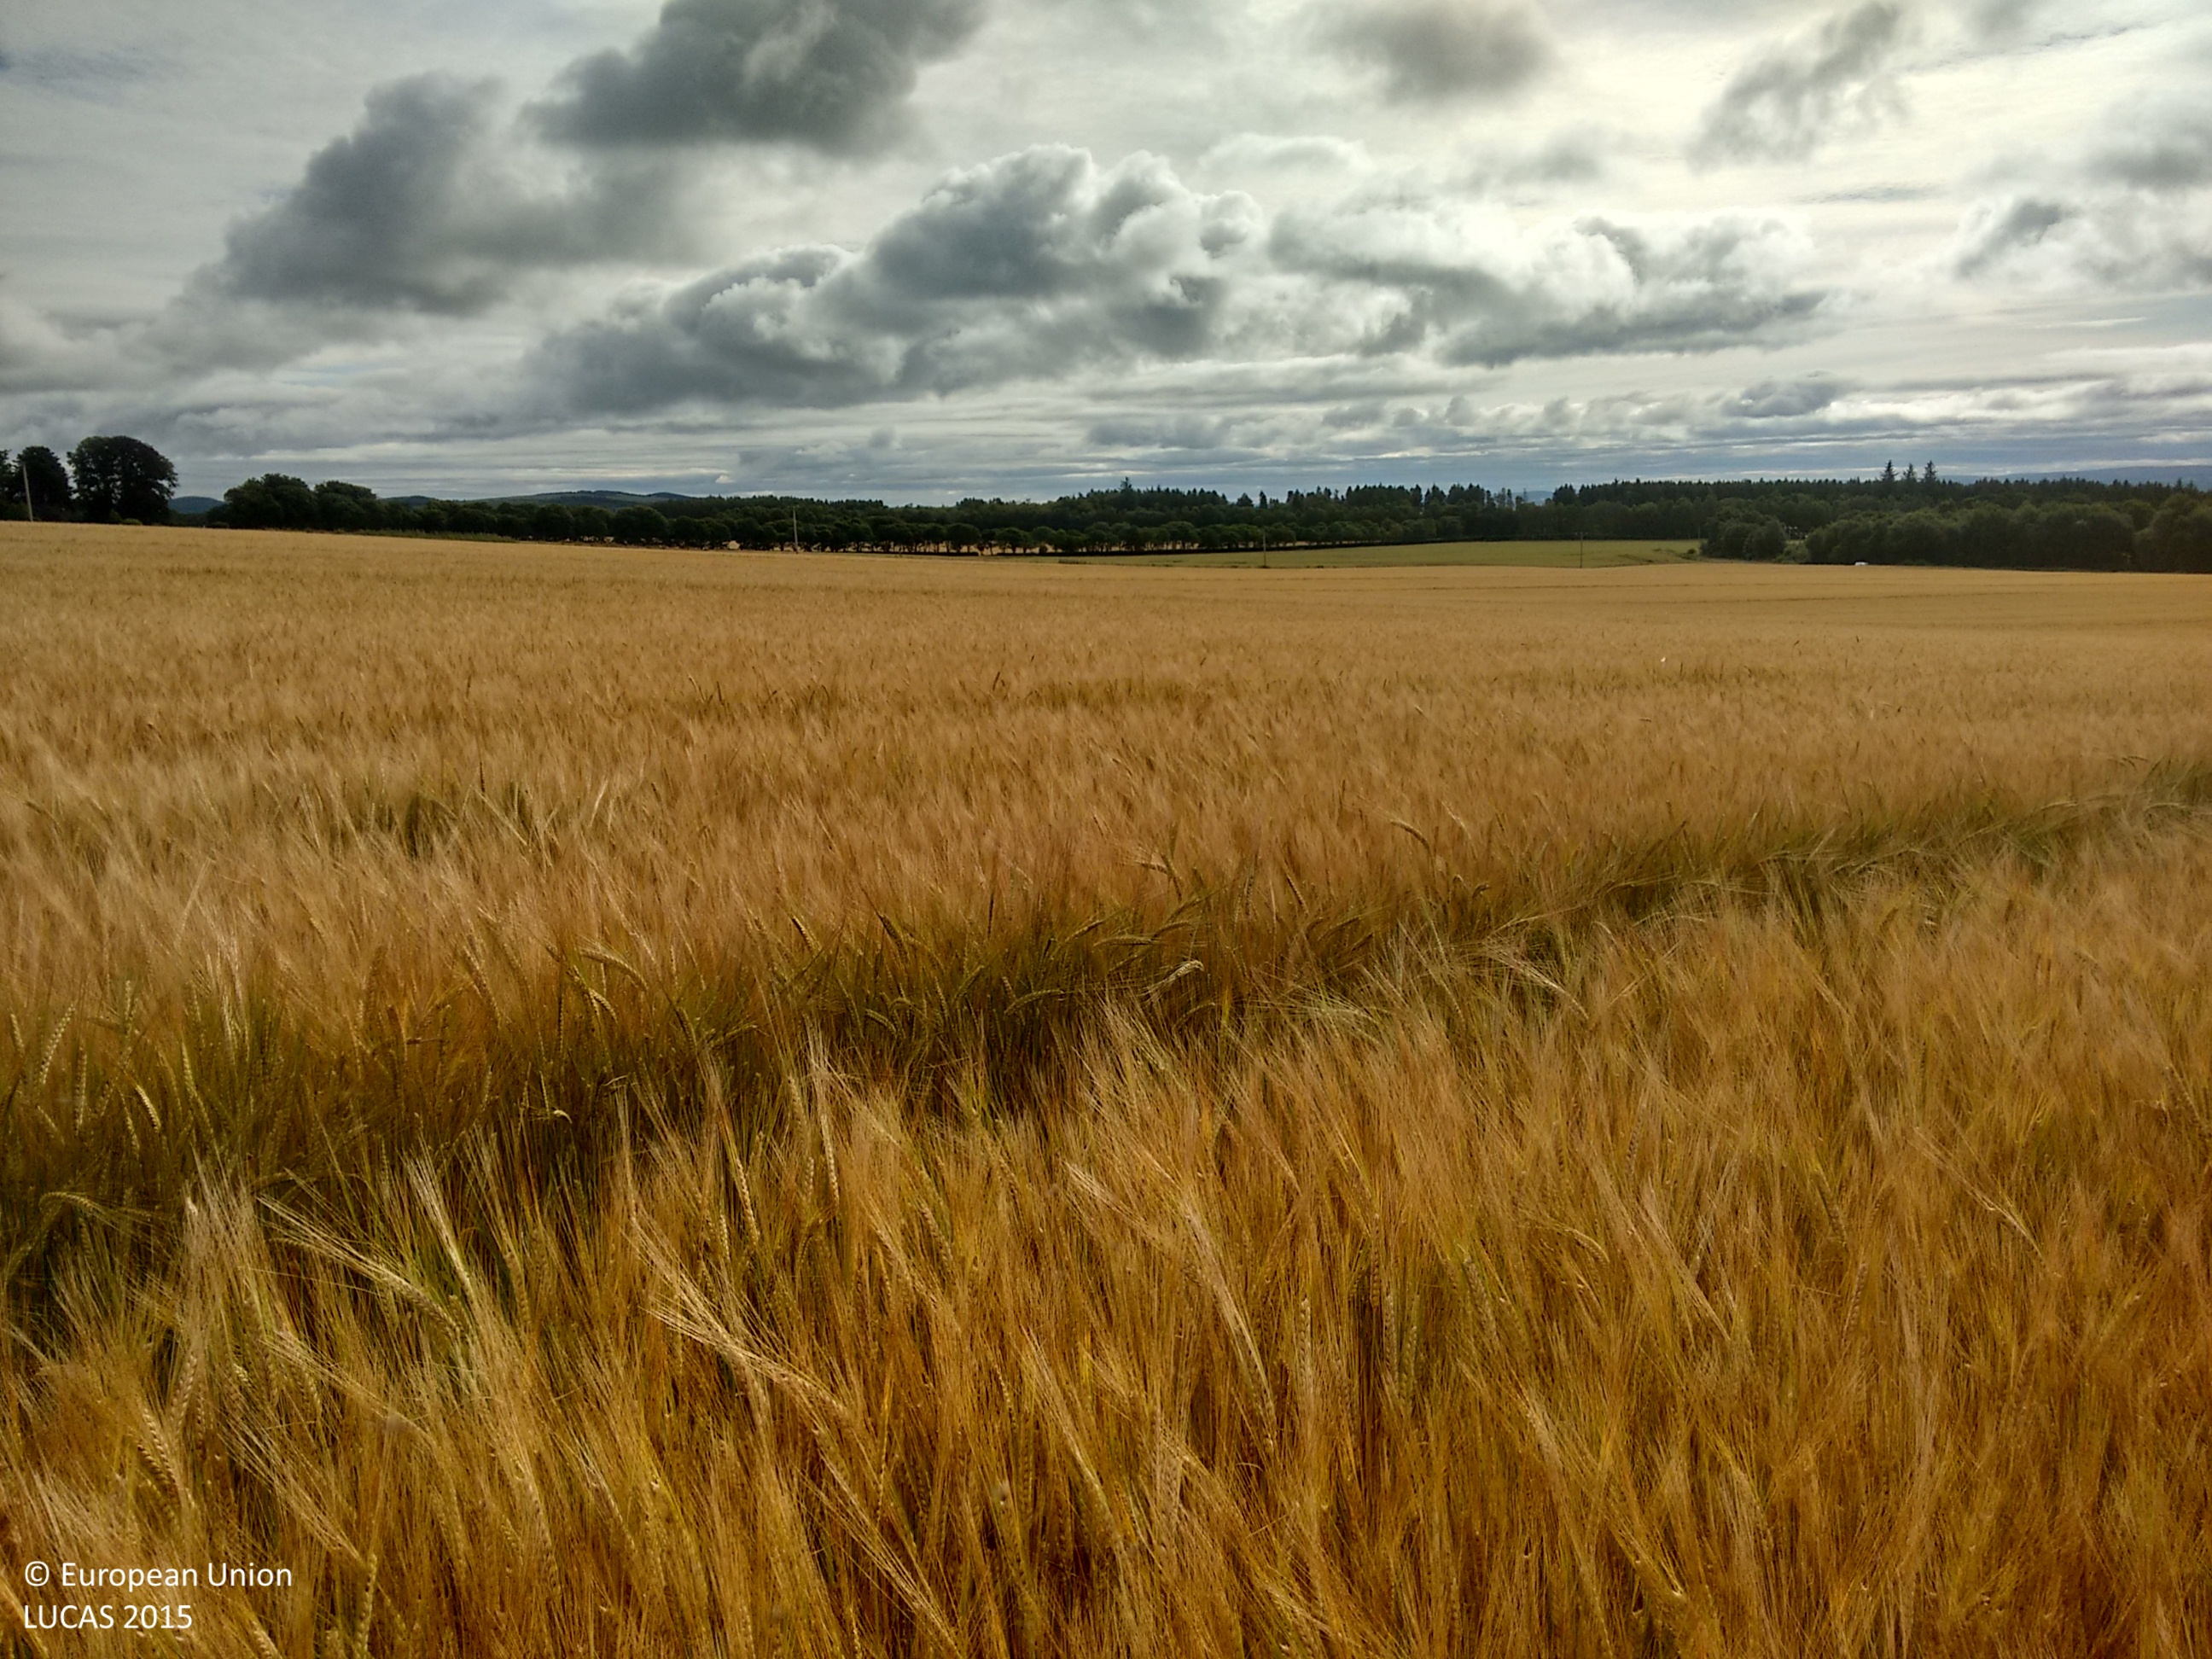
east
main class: Cropland
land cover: Barley
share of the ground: > 75 %
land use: Agriculture (excluding fallow land and kitchen gardens)
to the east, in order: Barley; Grassland without tree/shrub cover; Electric lines; Grassland without tree/shrub cover; Common wheat
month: August
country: GB
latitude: 57.5615
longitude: -4.2771
